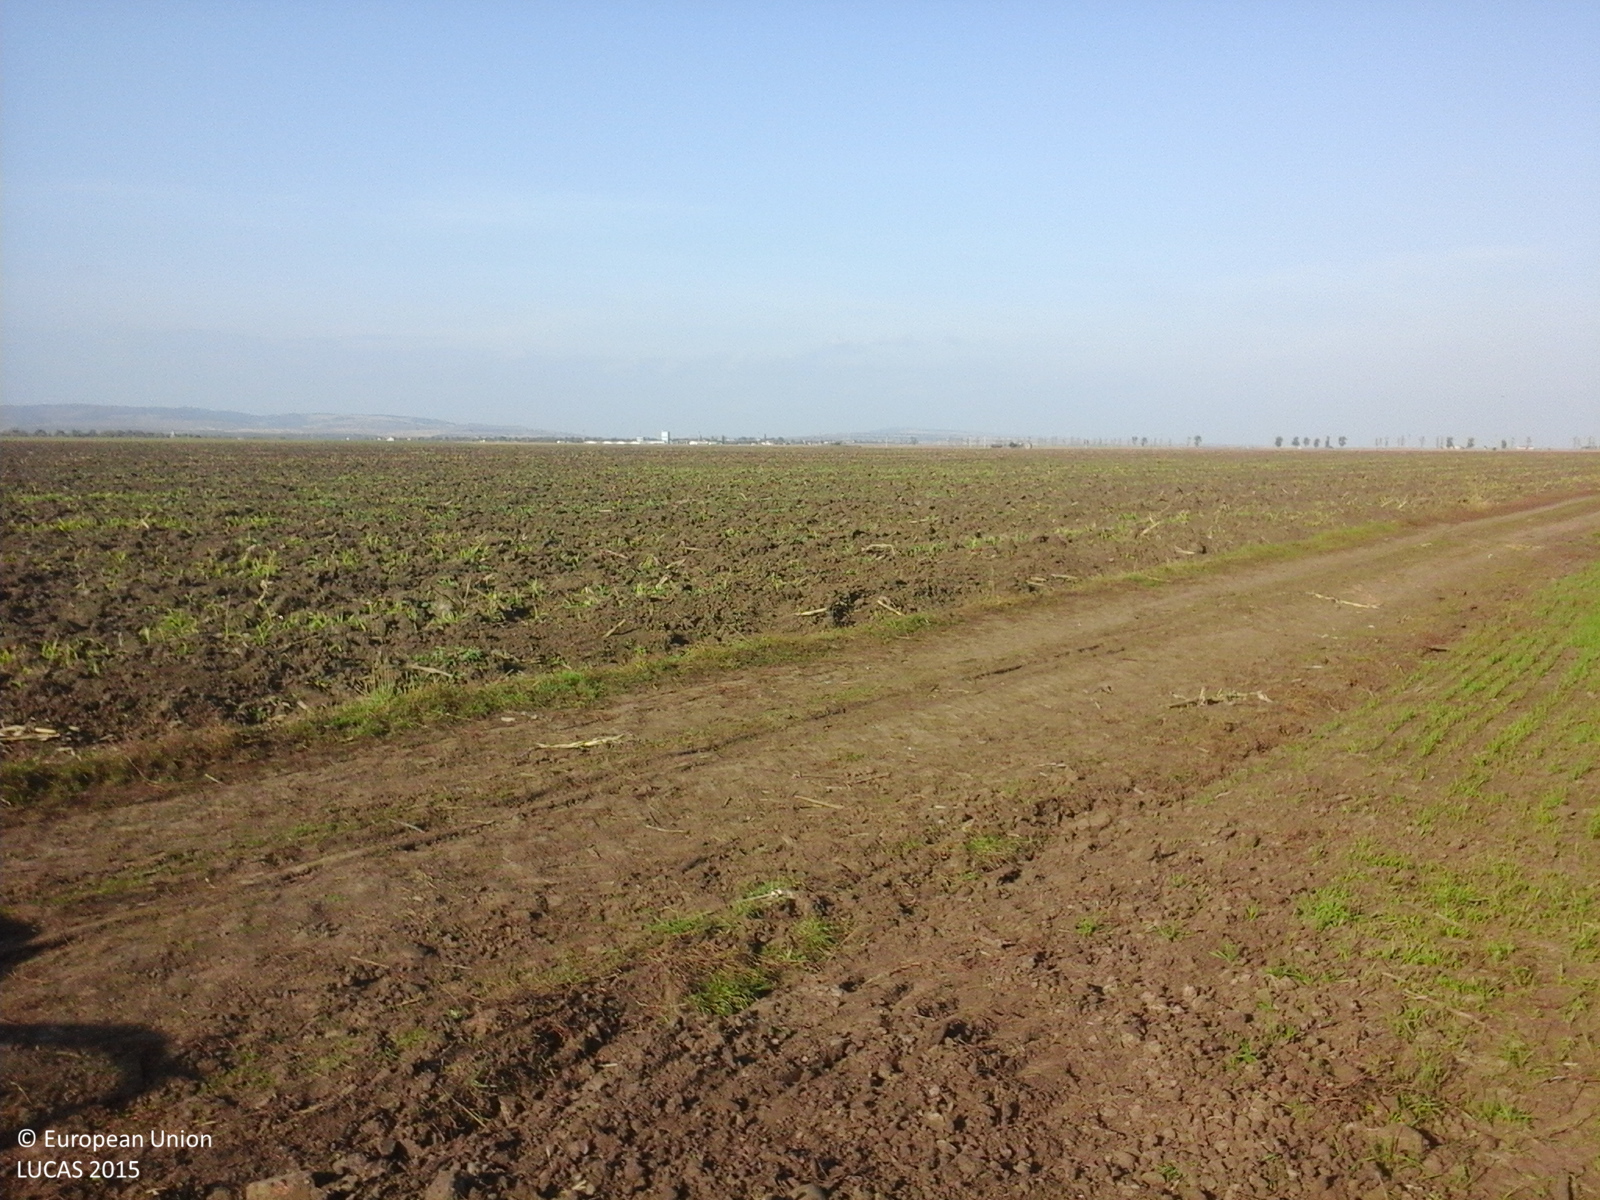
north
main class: Cropland
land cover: Common wheat
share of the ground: < 10 %
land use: Agriculture (excluding fallow land and kitchen gardens)
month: October
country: RO
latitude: 45.2005
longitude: 26.8731
